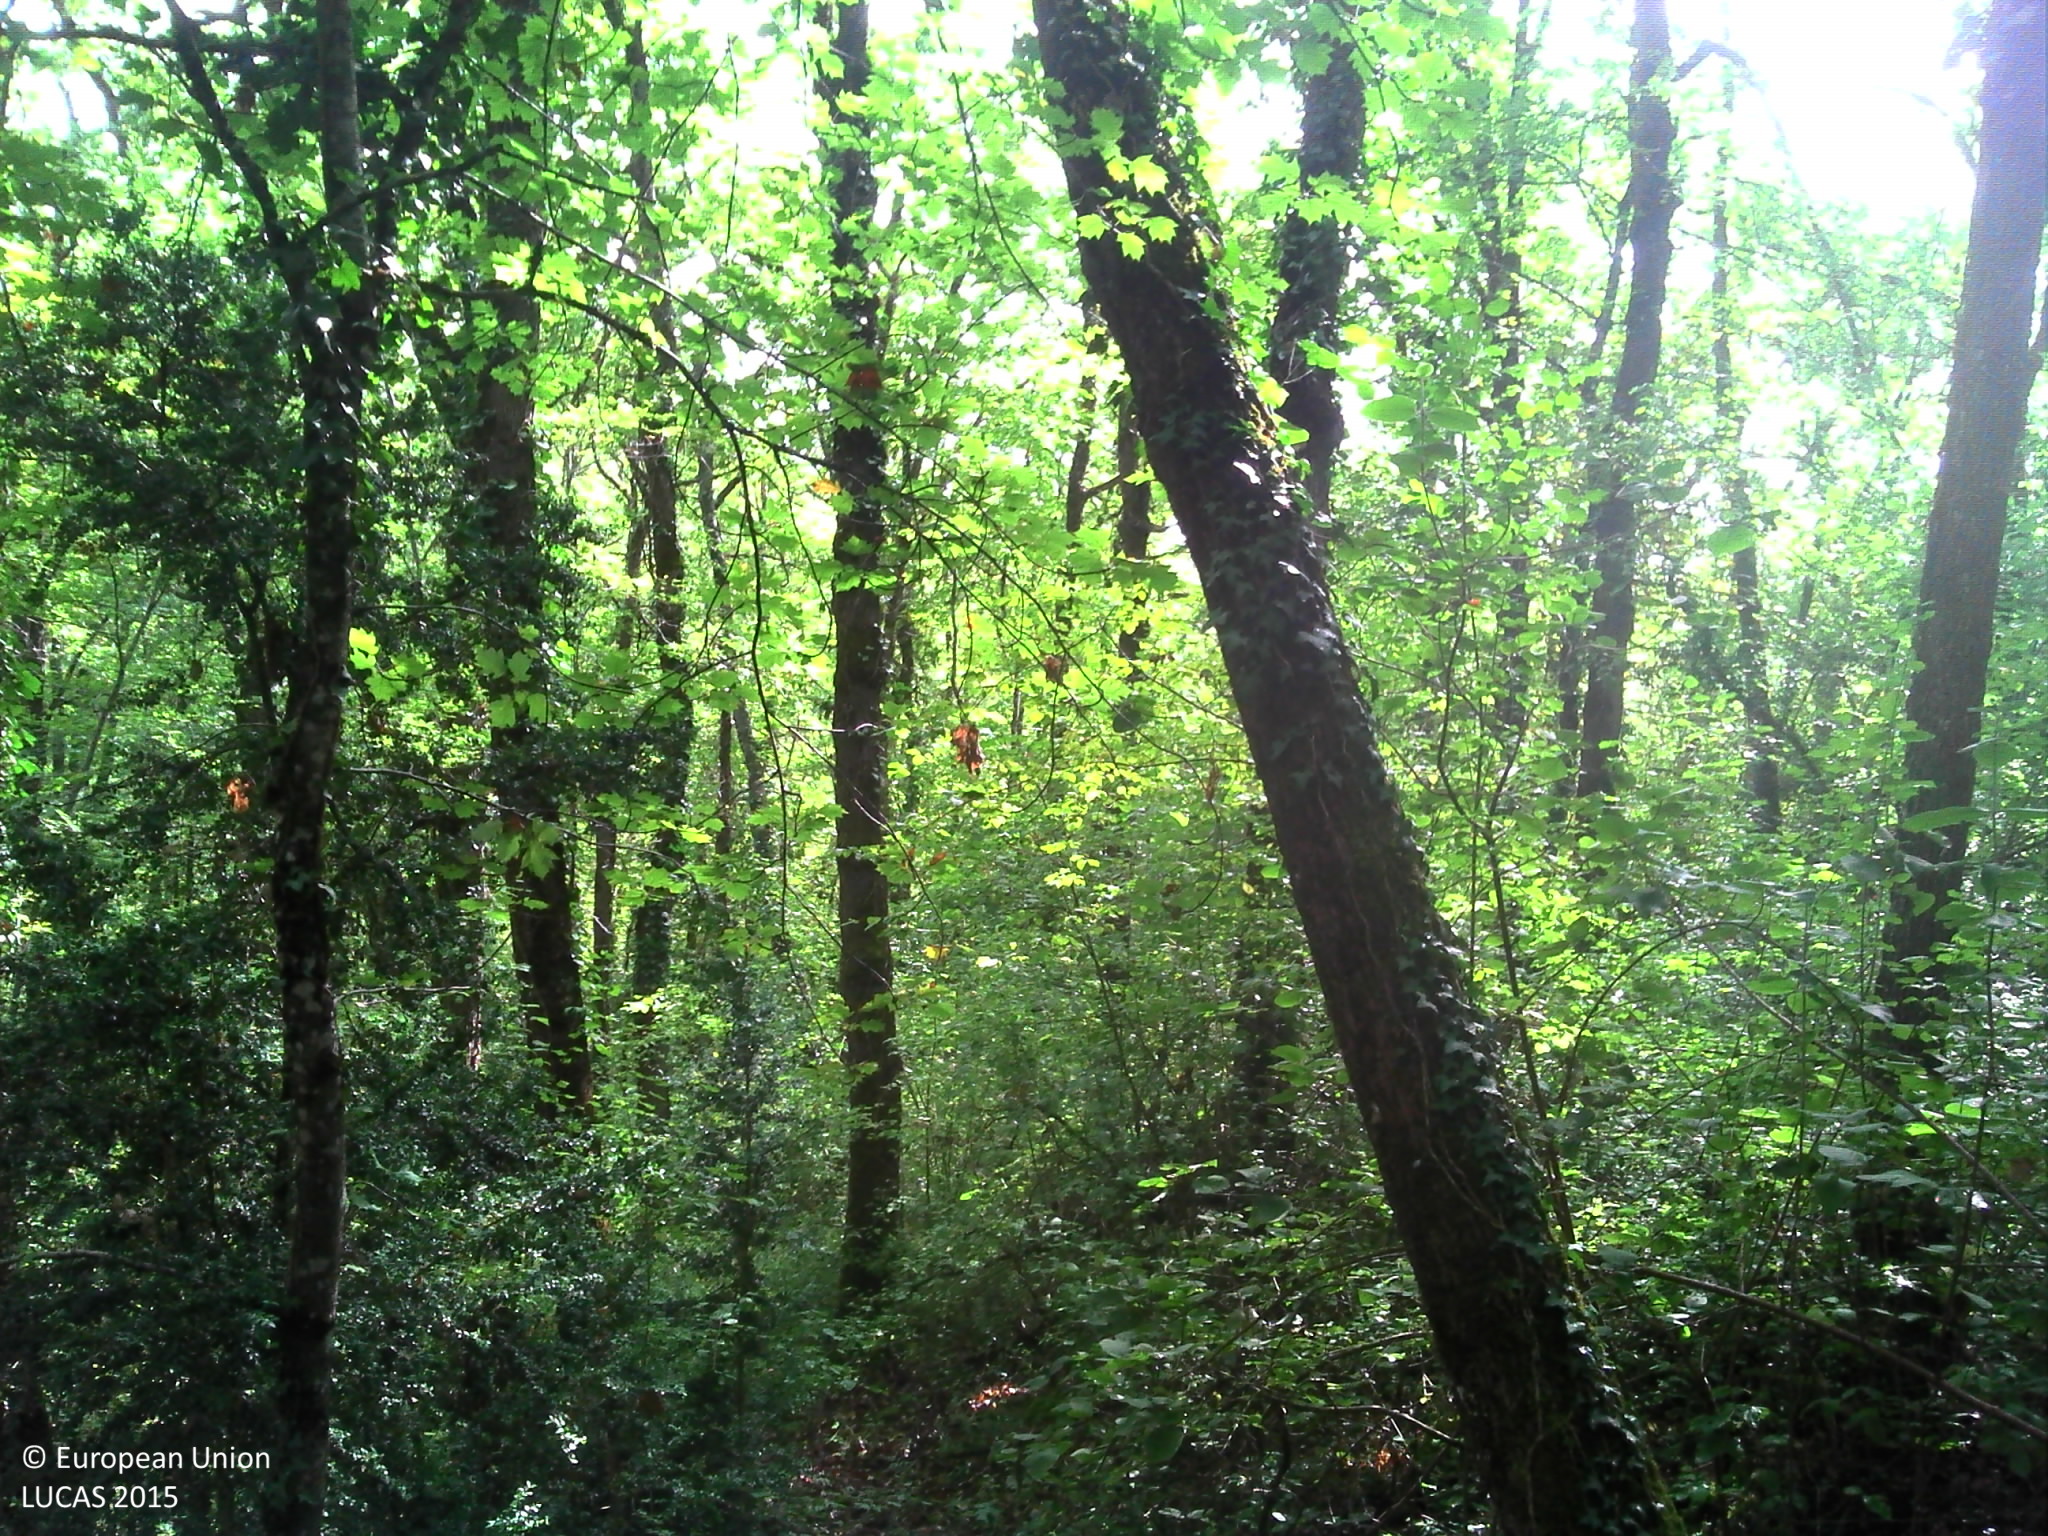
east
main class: Woodland
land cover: Broadleaved woodland
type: mesophytic deciduous forest
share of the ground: > 75 %
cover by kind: broadleaved forest trees 80 %, shrubs 10 %, herbaceous plants 10 %
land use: Forestry
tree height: > 5 m
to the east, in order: Broadleaved woodland; Tracks; Broadleaved woodland; Tracks; Broadleaved woodland; Grassland without tree/shrub cover; Abandoned hedges; Ditches and canals; Abandoned hedges; Grassland without tree/shrub cover; Broadleaved woodland; Tracks; Broadleaved woodland; Tracks; Broadleaved woodland; Tracks; Broadleaved woodland
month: August
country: FR
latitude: 44.2581
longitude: 1.3184
